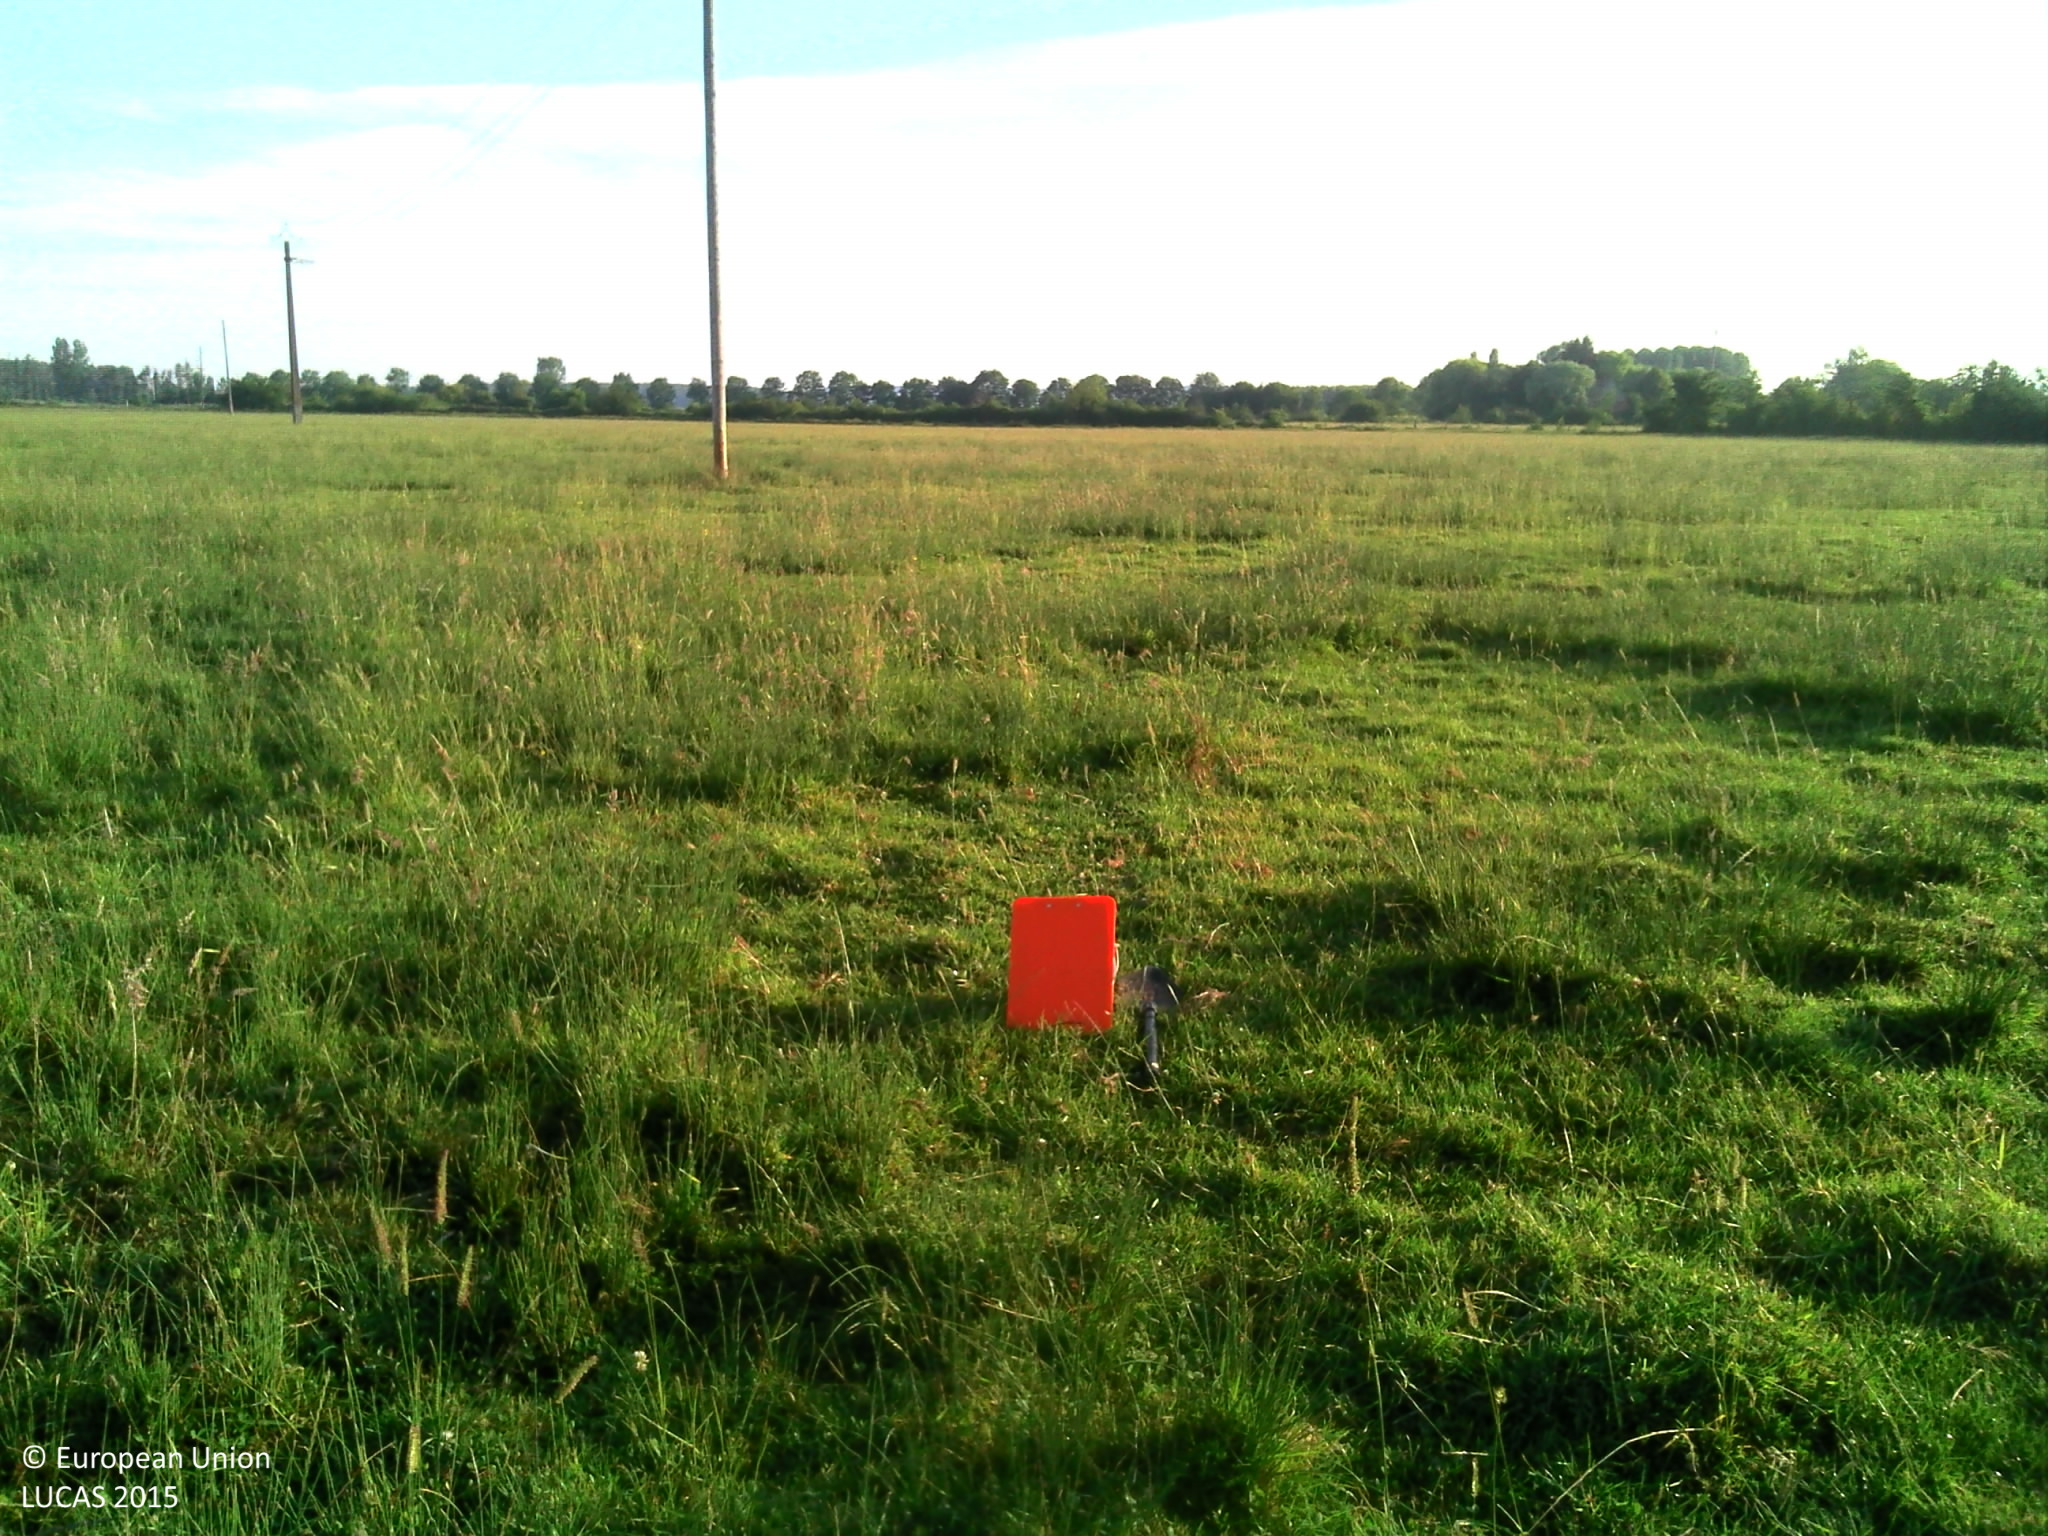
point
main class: Grassland
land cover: Grassland without tree/shrub cover
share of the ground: > 75 %
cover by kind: herbaceous plants 100 %
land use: Agriculture (excluding fallow land and kitchen gardens)
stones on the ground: < 10 %
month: June
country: FR
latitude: 49.1254
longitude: -0.0209
